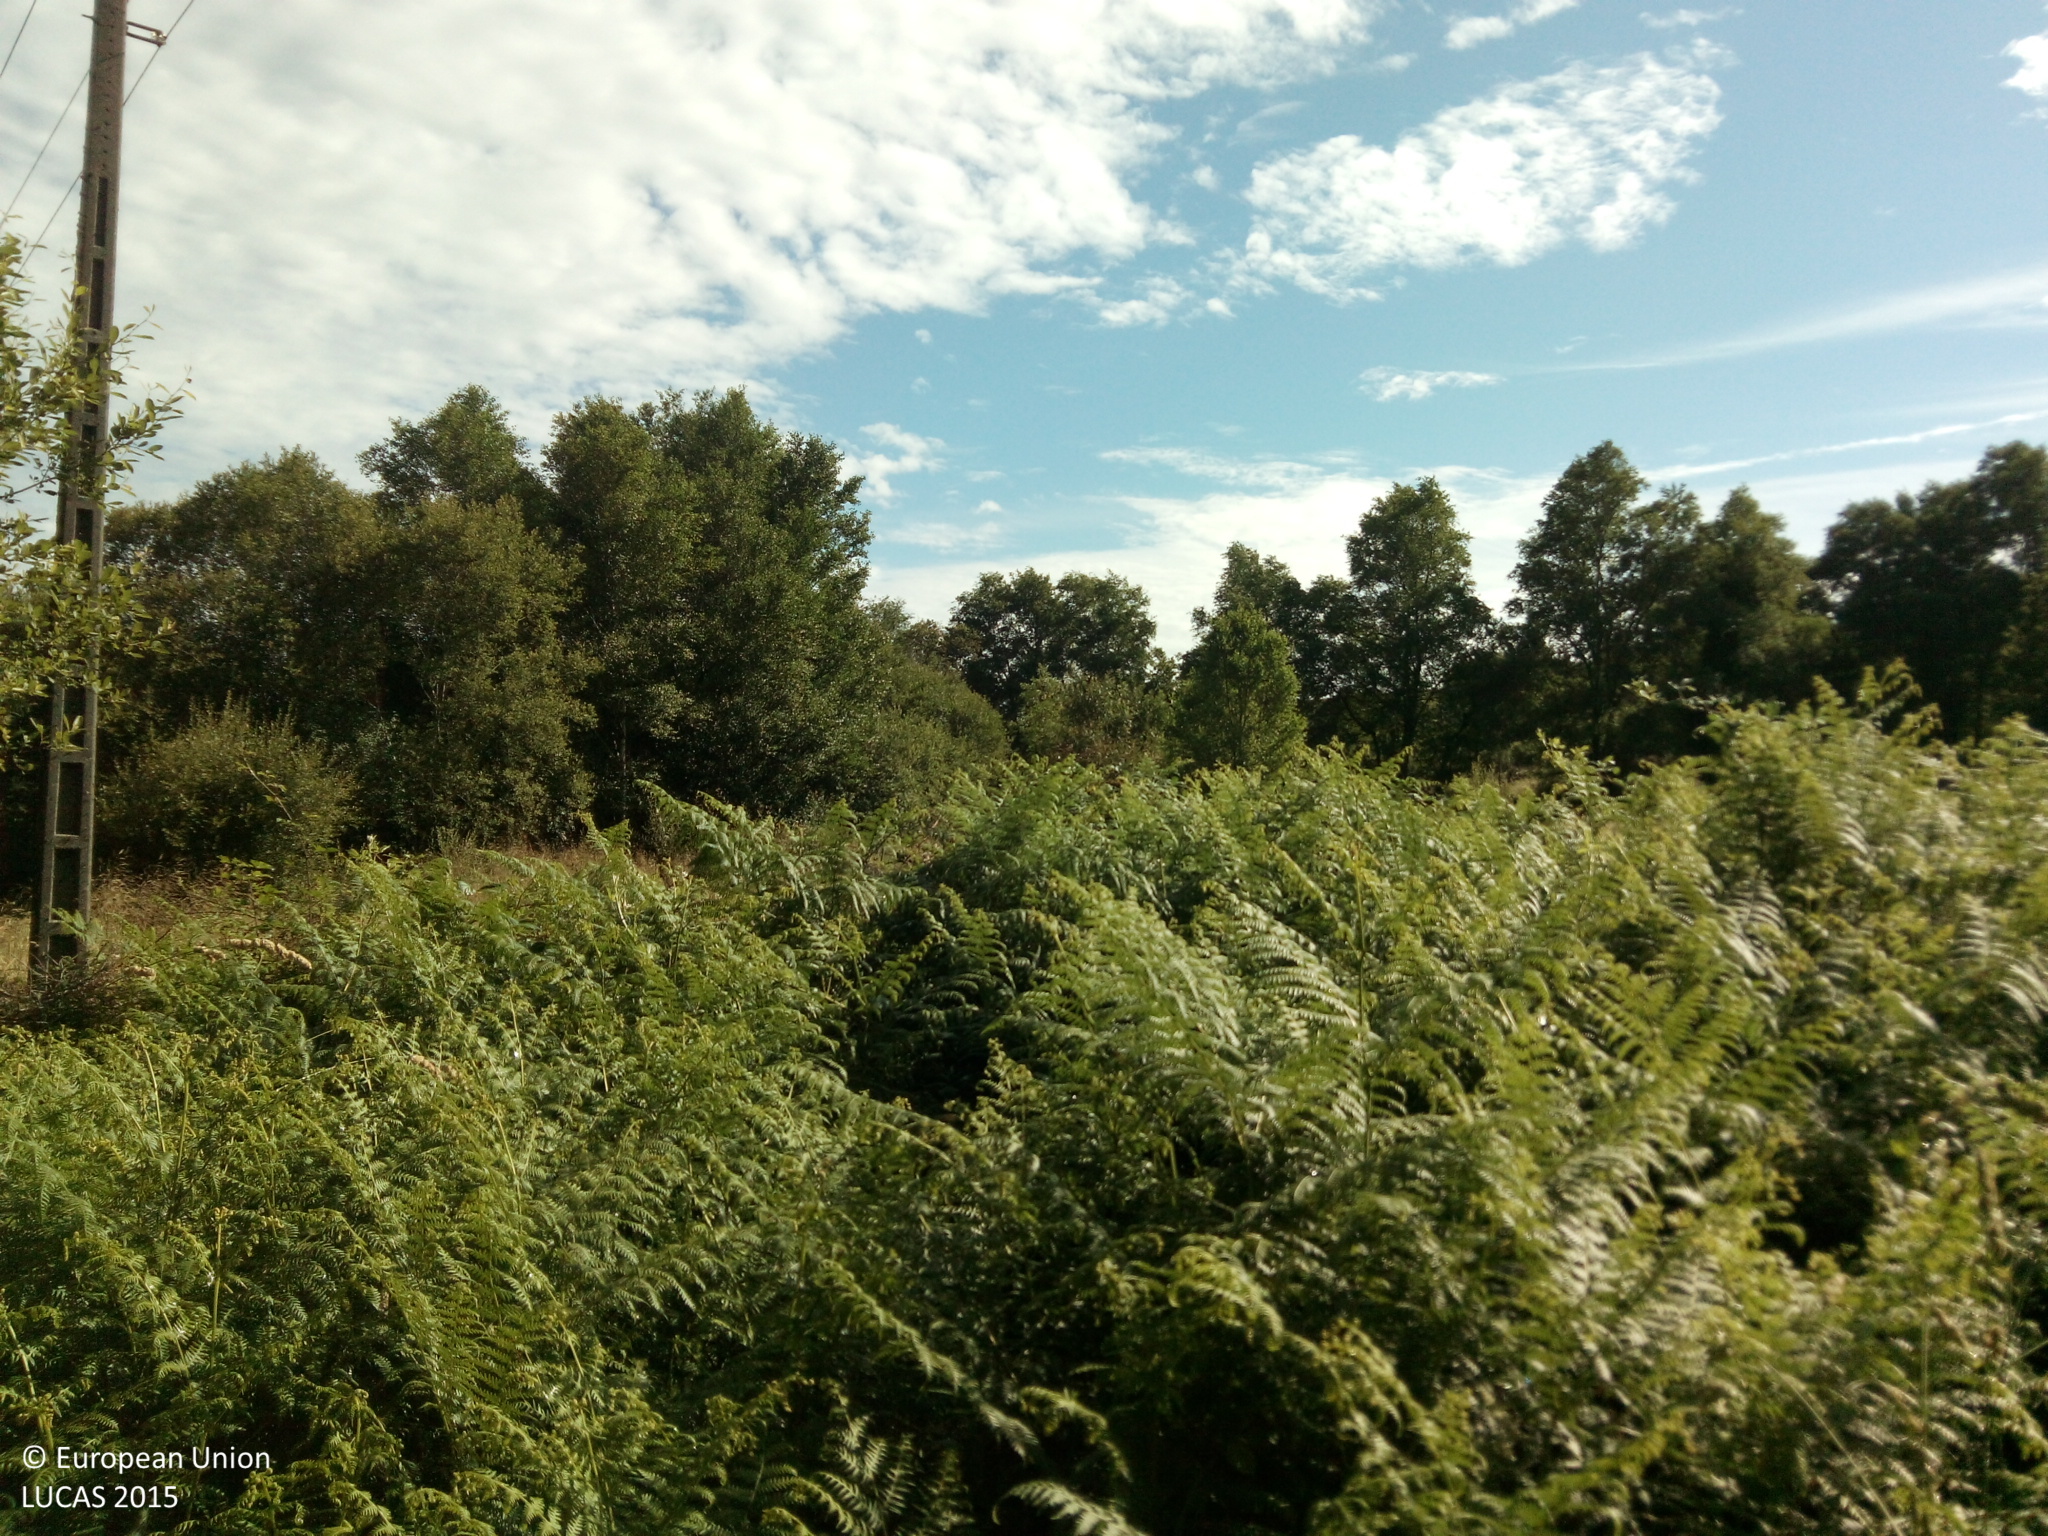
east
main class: Grassland
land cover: Grassland with sparse tree/shrub cover
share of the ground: > 75 %
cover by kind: herbaceous plants 95 %, coniferous forest trees 5 %
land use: Abandoned areas
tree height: < 5 m
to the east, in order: Grassland with sparse tree/shrub cover; Electric lines; Spontaneously vegetated surfaces; Dry stone walls; Lines of trees; Tracks; Dry stone walls; Grassland without tree/shrub cover; Dry stone walls; Grassland without tree/shrub cover; Fences; Grassland without tree/shrub cover; Fences; Grassland without tree/shrub cover; Shrubland without tree cover; Grassland without tree/shrub cover; Dry stone walls; Grassland without tree/shrub cover; Fences; Maize; Fences; Spontaneously vegetated surfaces; Grassland with sparse tree/shrub cover; Abandoned hedges; Dry stone walls; Paved roads, cycling and walking lanes
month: July
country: ES
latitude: 42.3222
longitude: -8.2781
